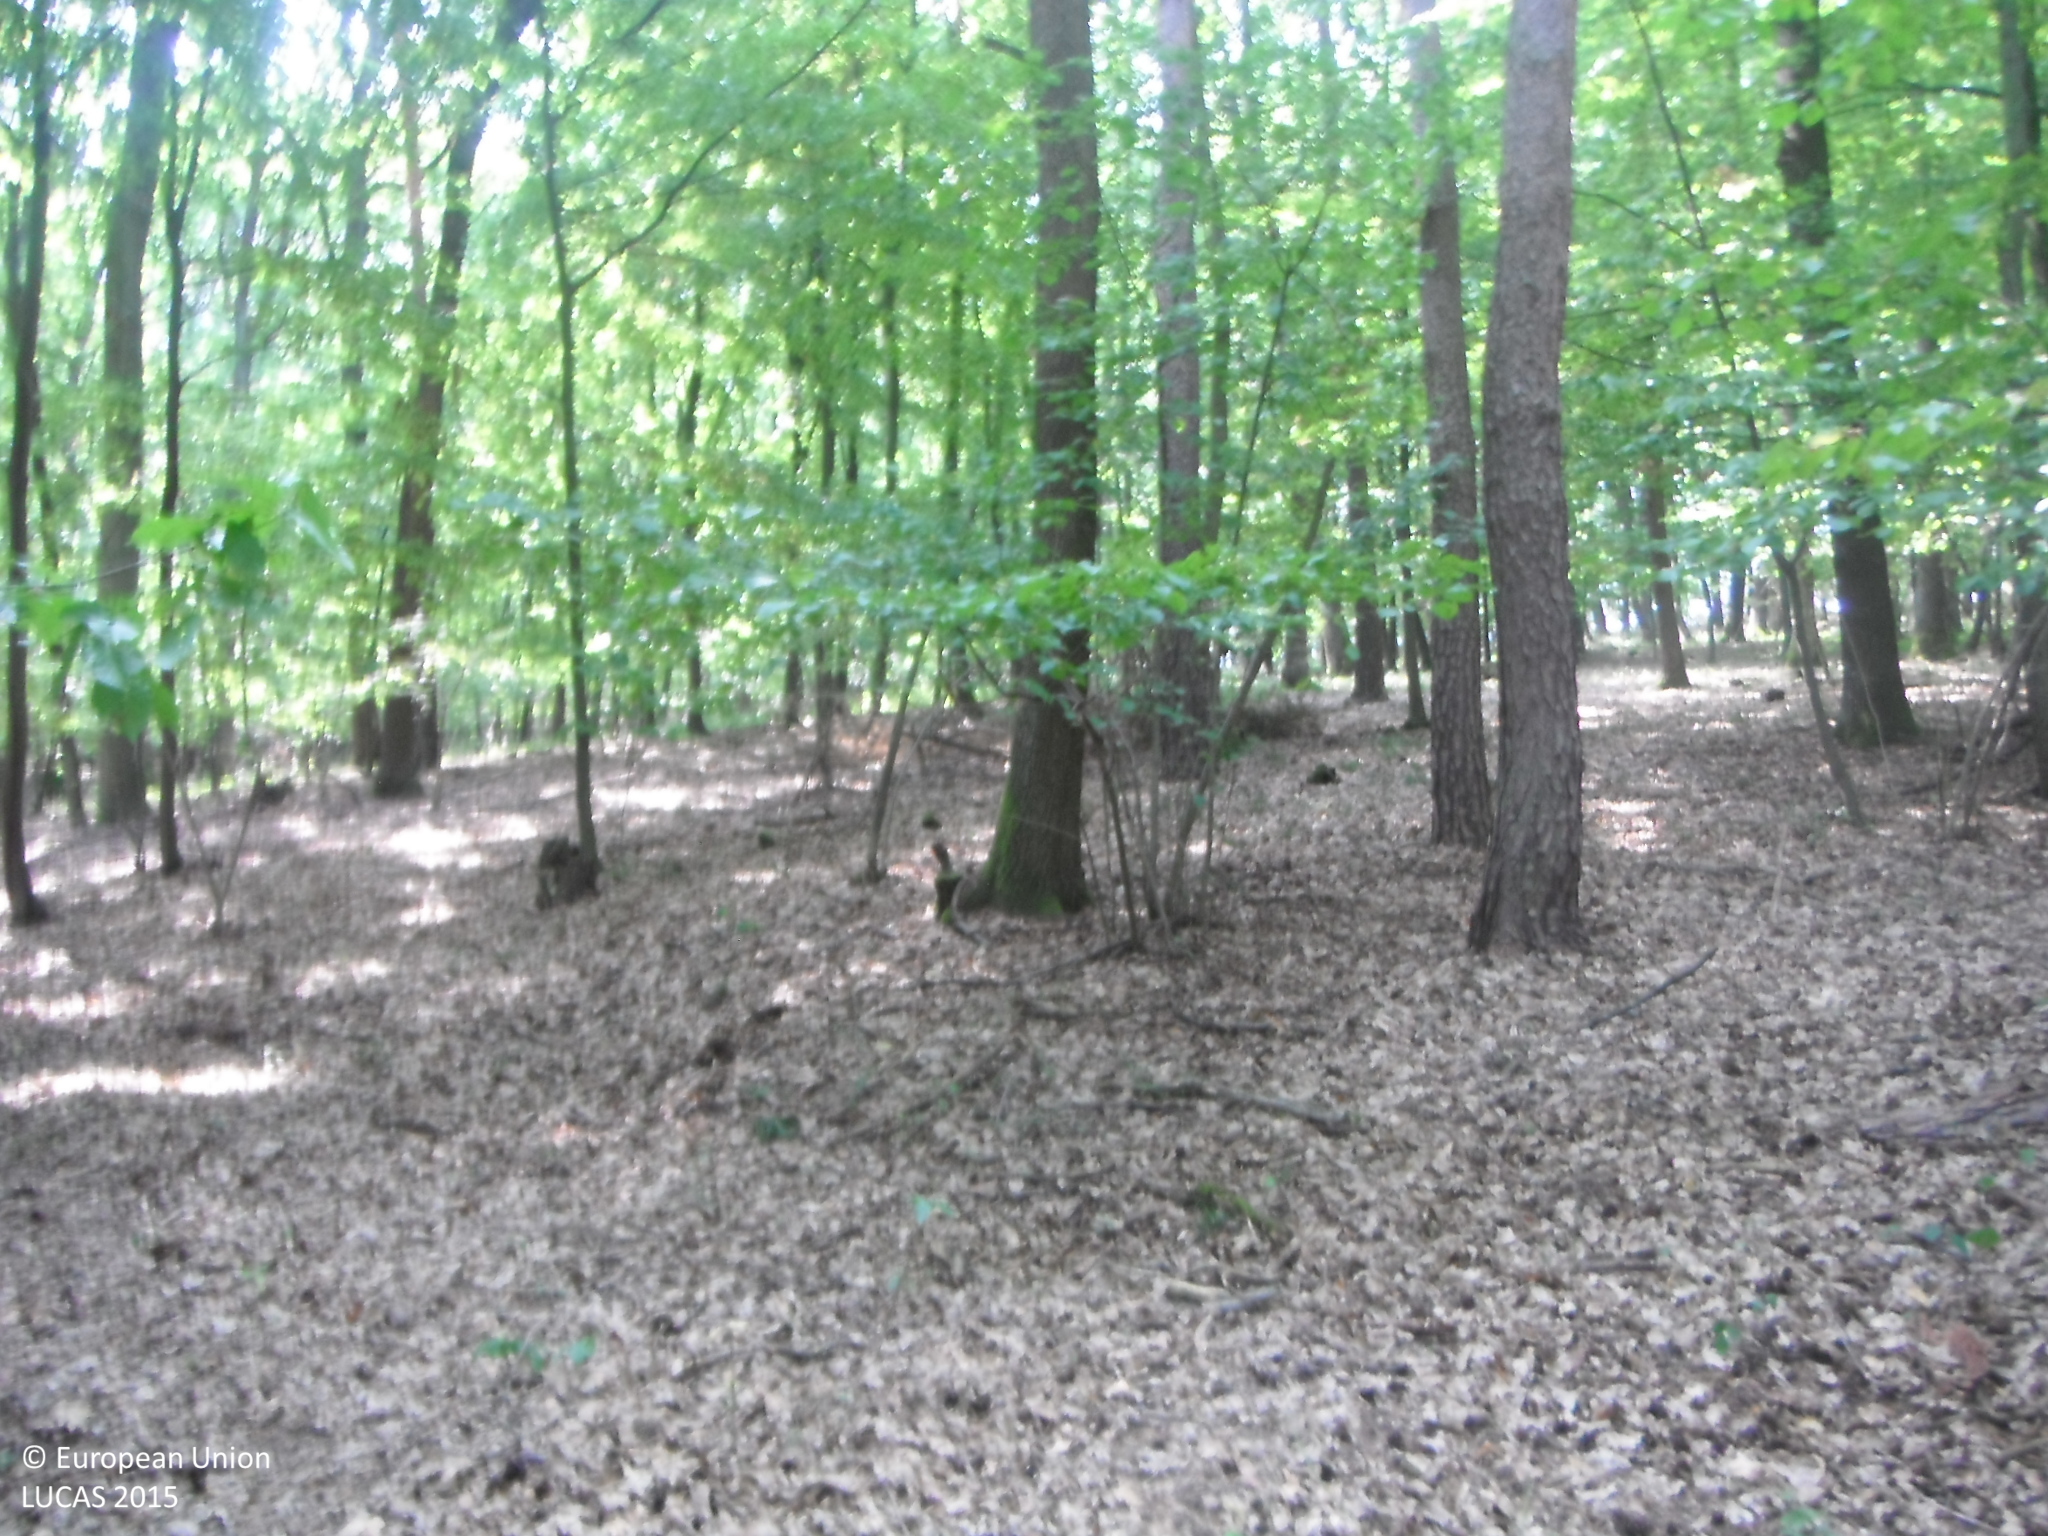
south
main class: Woodland
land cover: Broadleaved woodland
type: acidophilous oak and oak-birch forest
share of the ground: > 75 %
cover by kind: broadleaved forest trees 95 %, shrubs 5 %
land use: Forestry
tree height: > 5 m
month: August
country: SK
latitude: 48.7166
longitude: 18.1564
